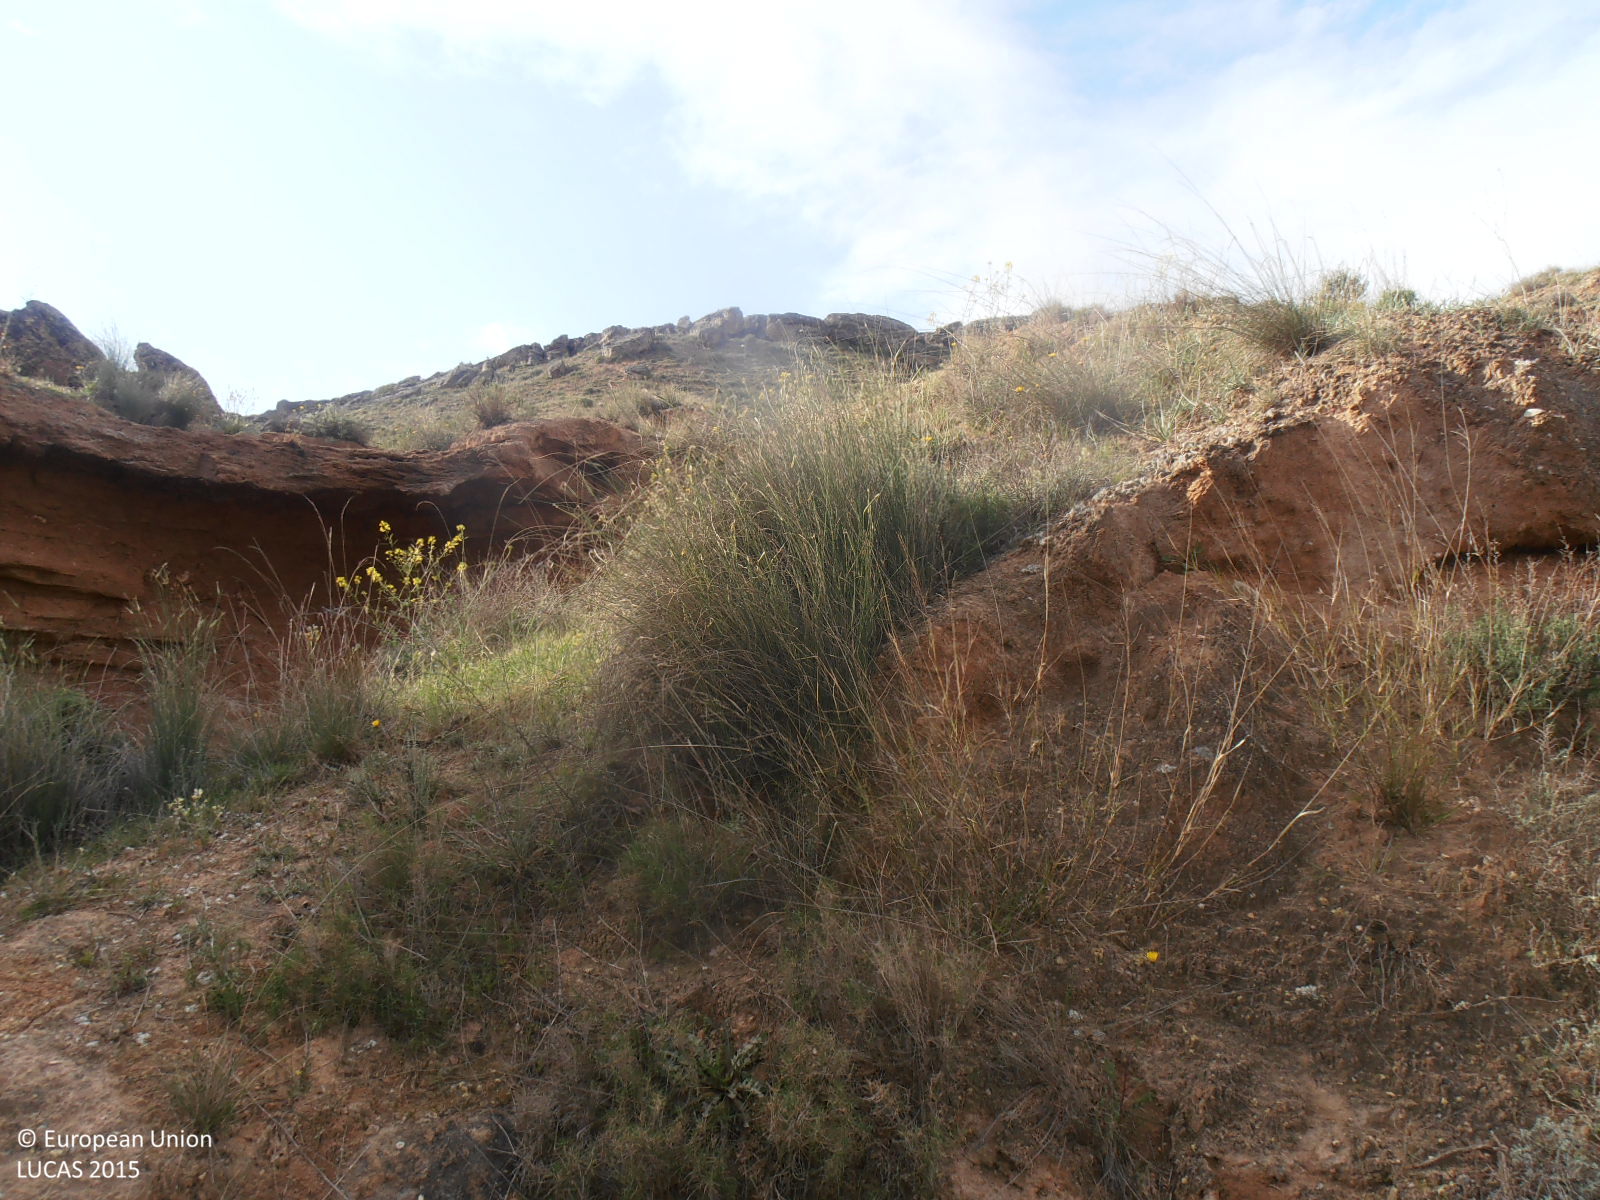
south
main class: Grassland
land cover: Grassland without tree/shrub cover
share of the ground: 50 - 75 %
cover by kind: herbaceous plants 60 %, consolidated bare surface 40 %
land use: Semi-natural and natural areas not in use
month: April
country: ES
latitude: 41.1915
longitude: -0.3752
